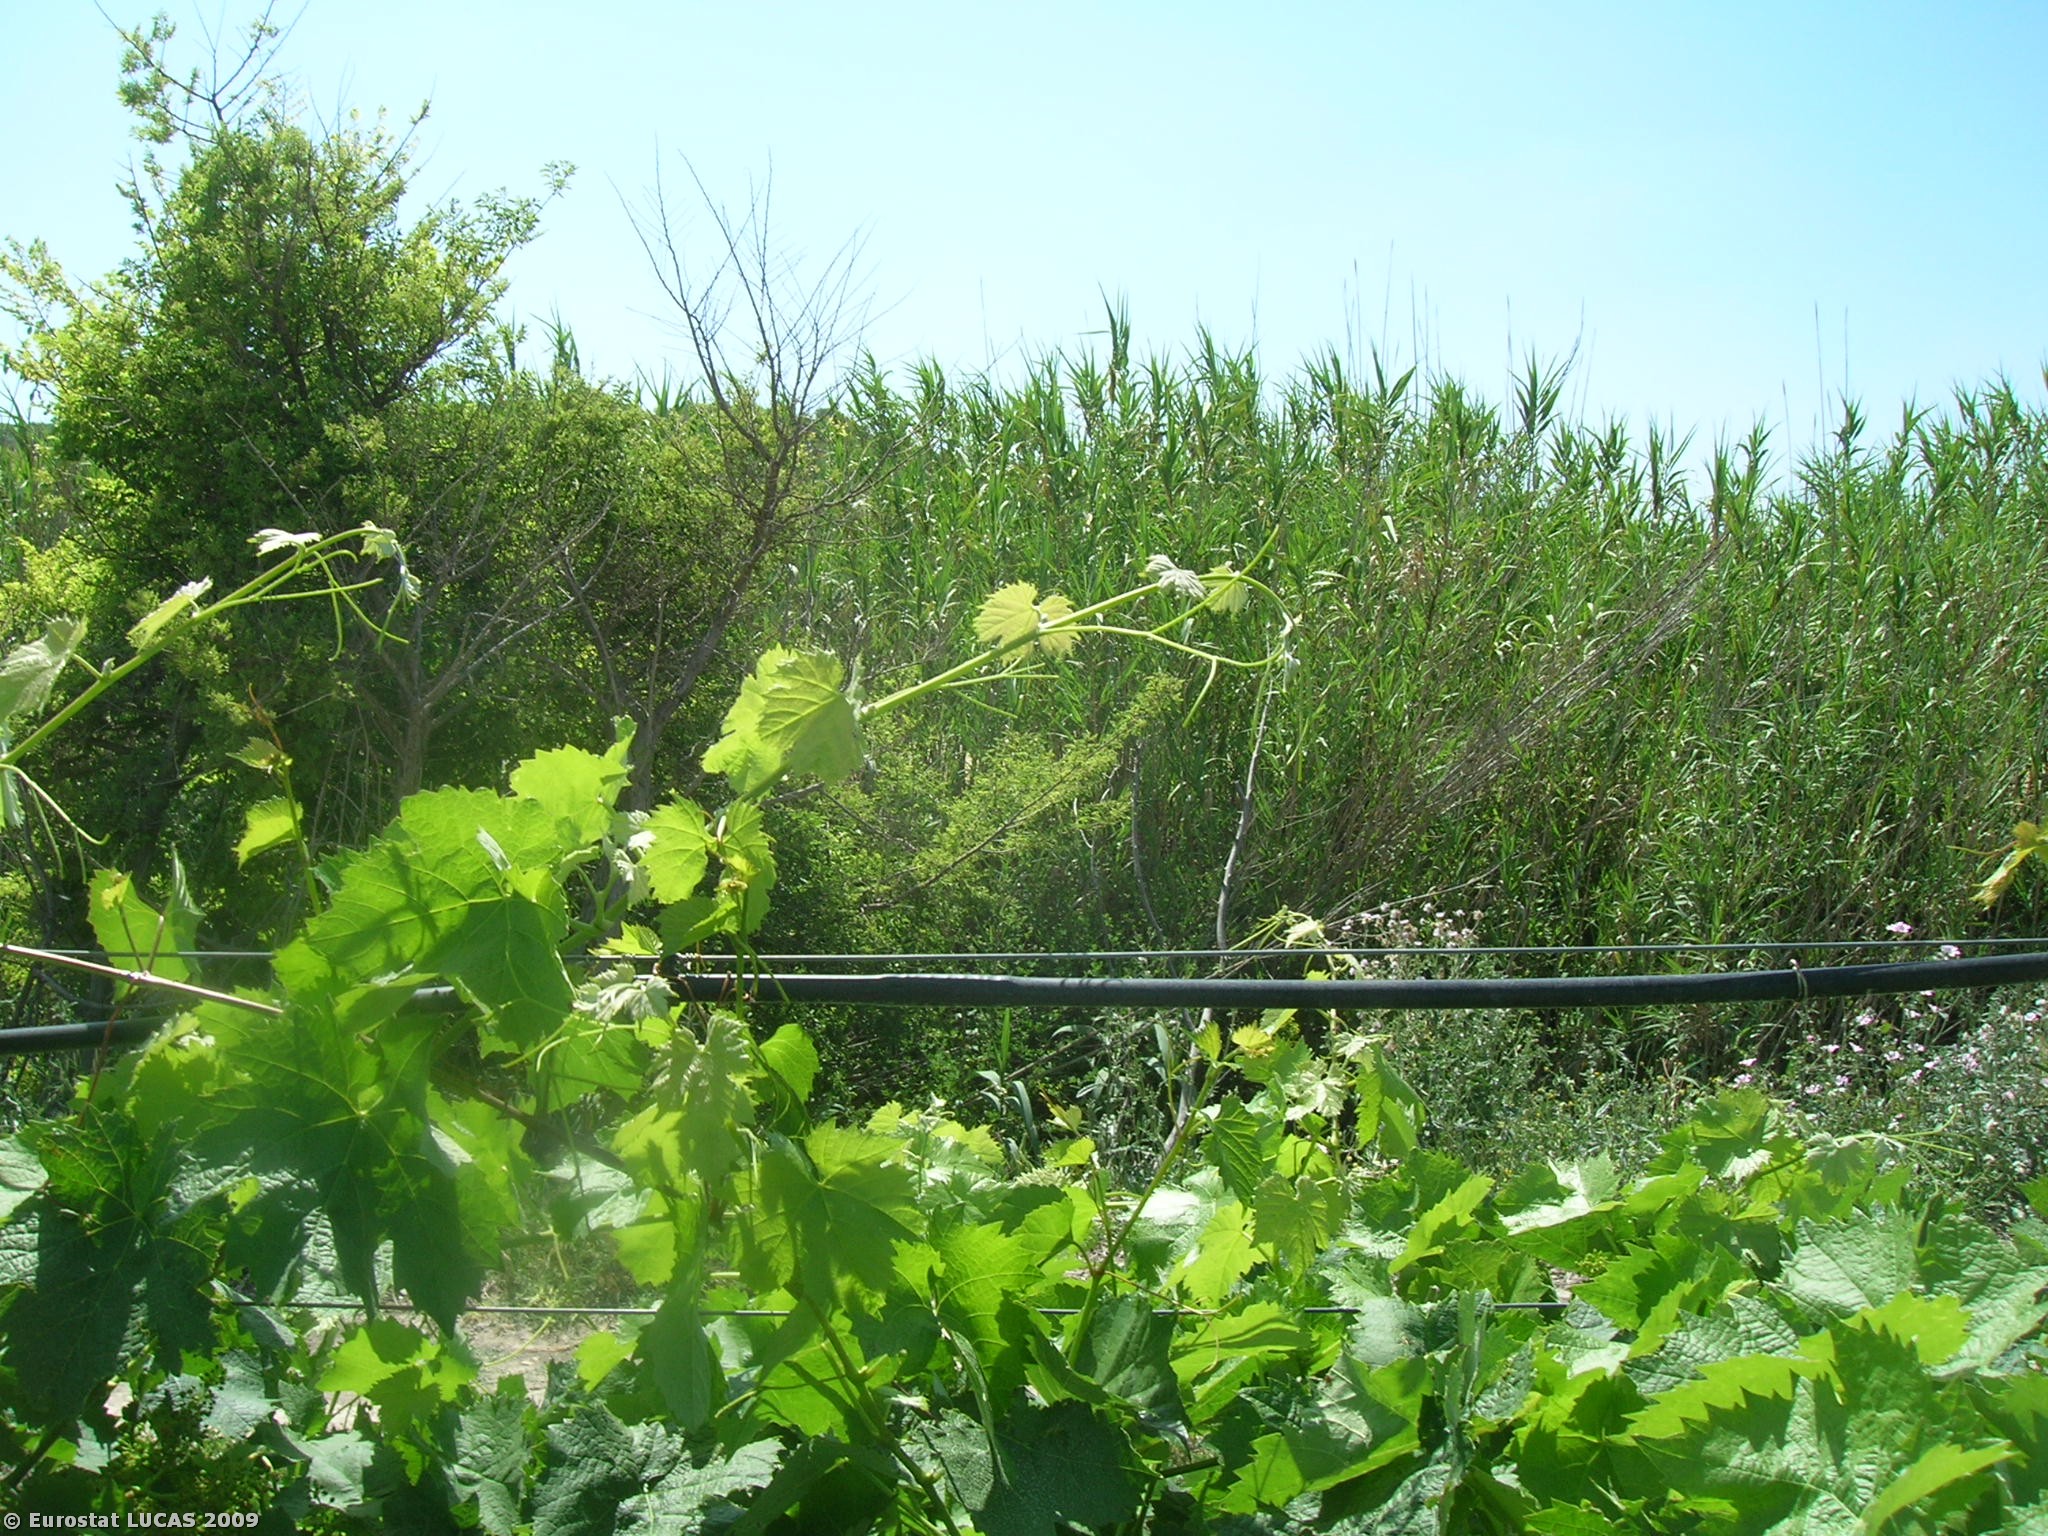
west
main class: Cropland
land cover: Vineyards
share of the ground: 50 - 75 %
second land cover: Bare land
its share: 50 - 75 %
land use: Agriculture (excluding fallow land and kitchen gardens)
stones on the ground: < 10 %
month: May
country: IT
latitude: 37.7101
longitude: 12.6683
